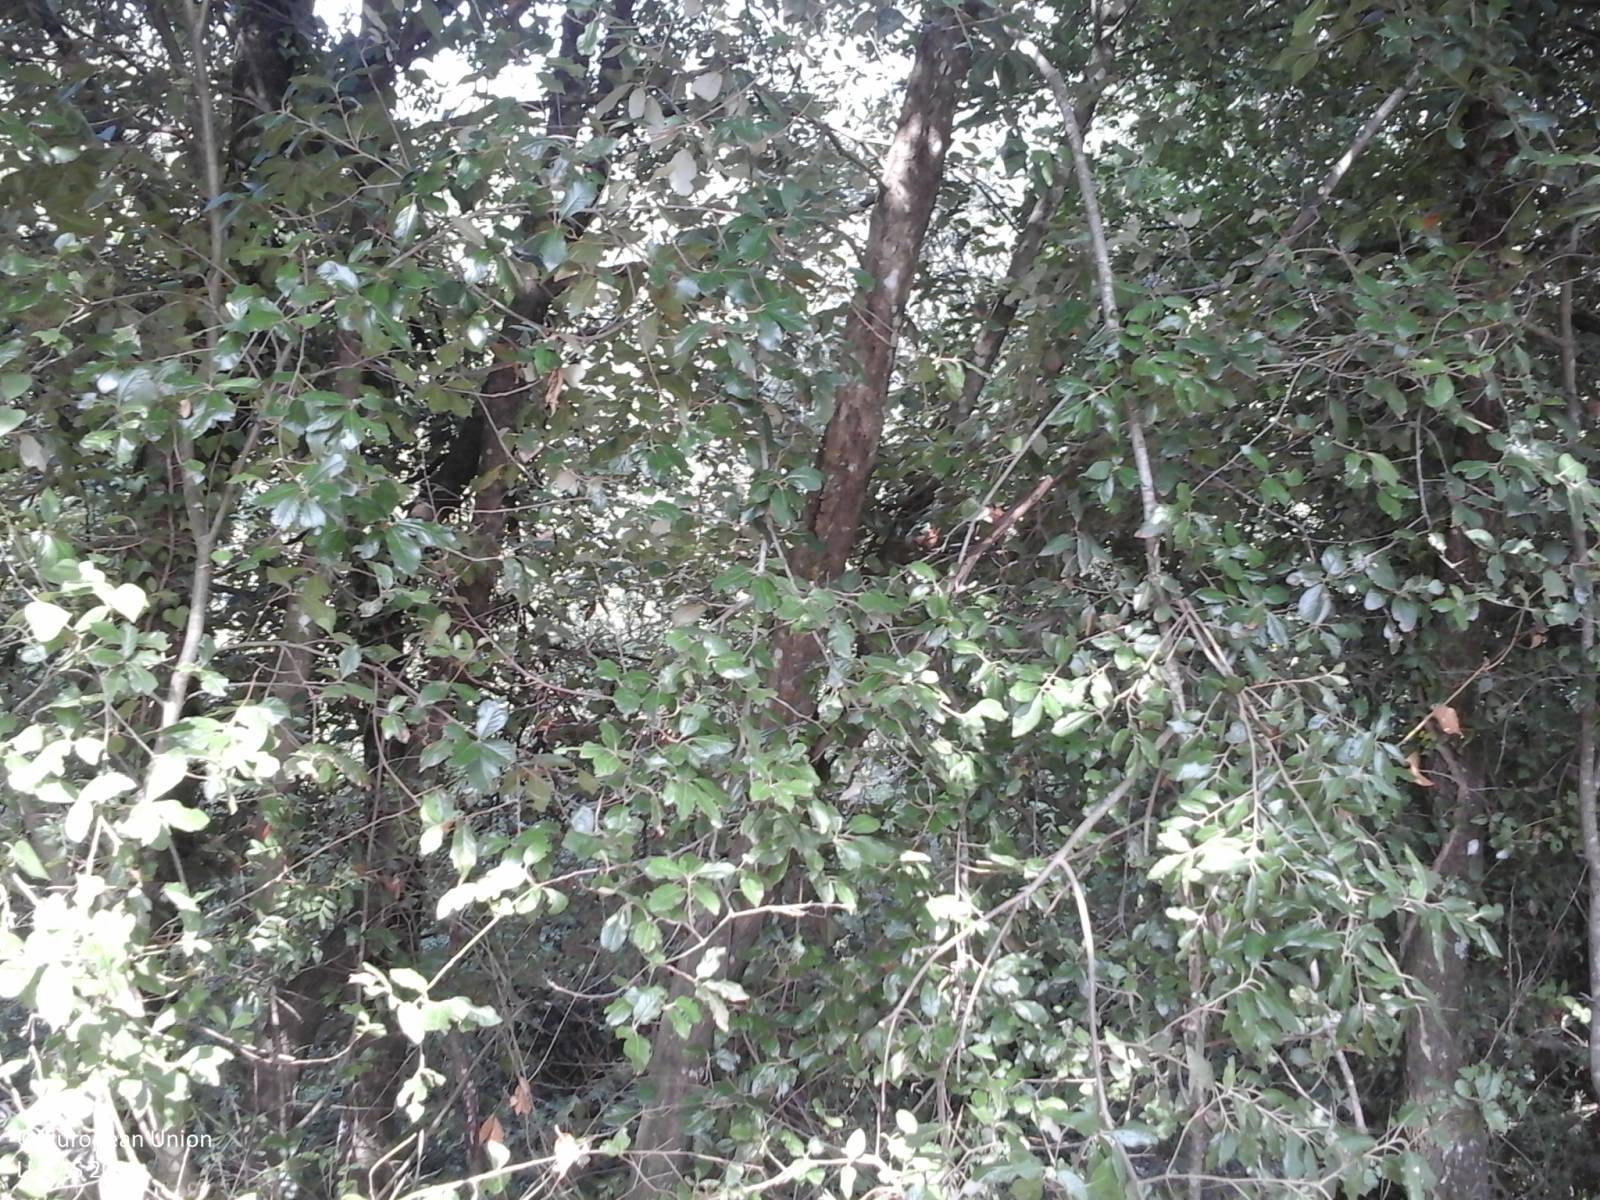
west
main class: Grassland
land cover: Grassland without tree/shrub cover
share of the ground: > 75 %
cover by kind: herbaceous plants 100 %
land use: Agriculture (excluding fallow land and kitchen gardens)
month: August
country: IT
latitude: 41.5378
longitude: 13.1641
